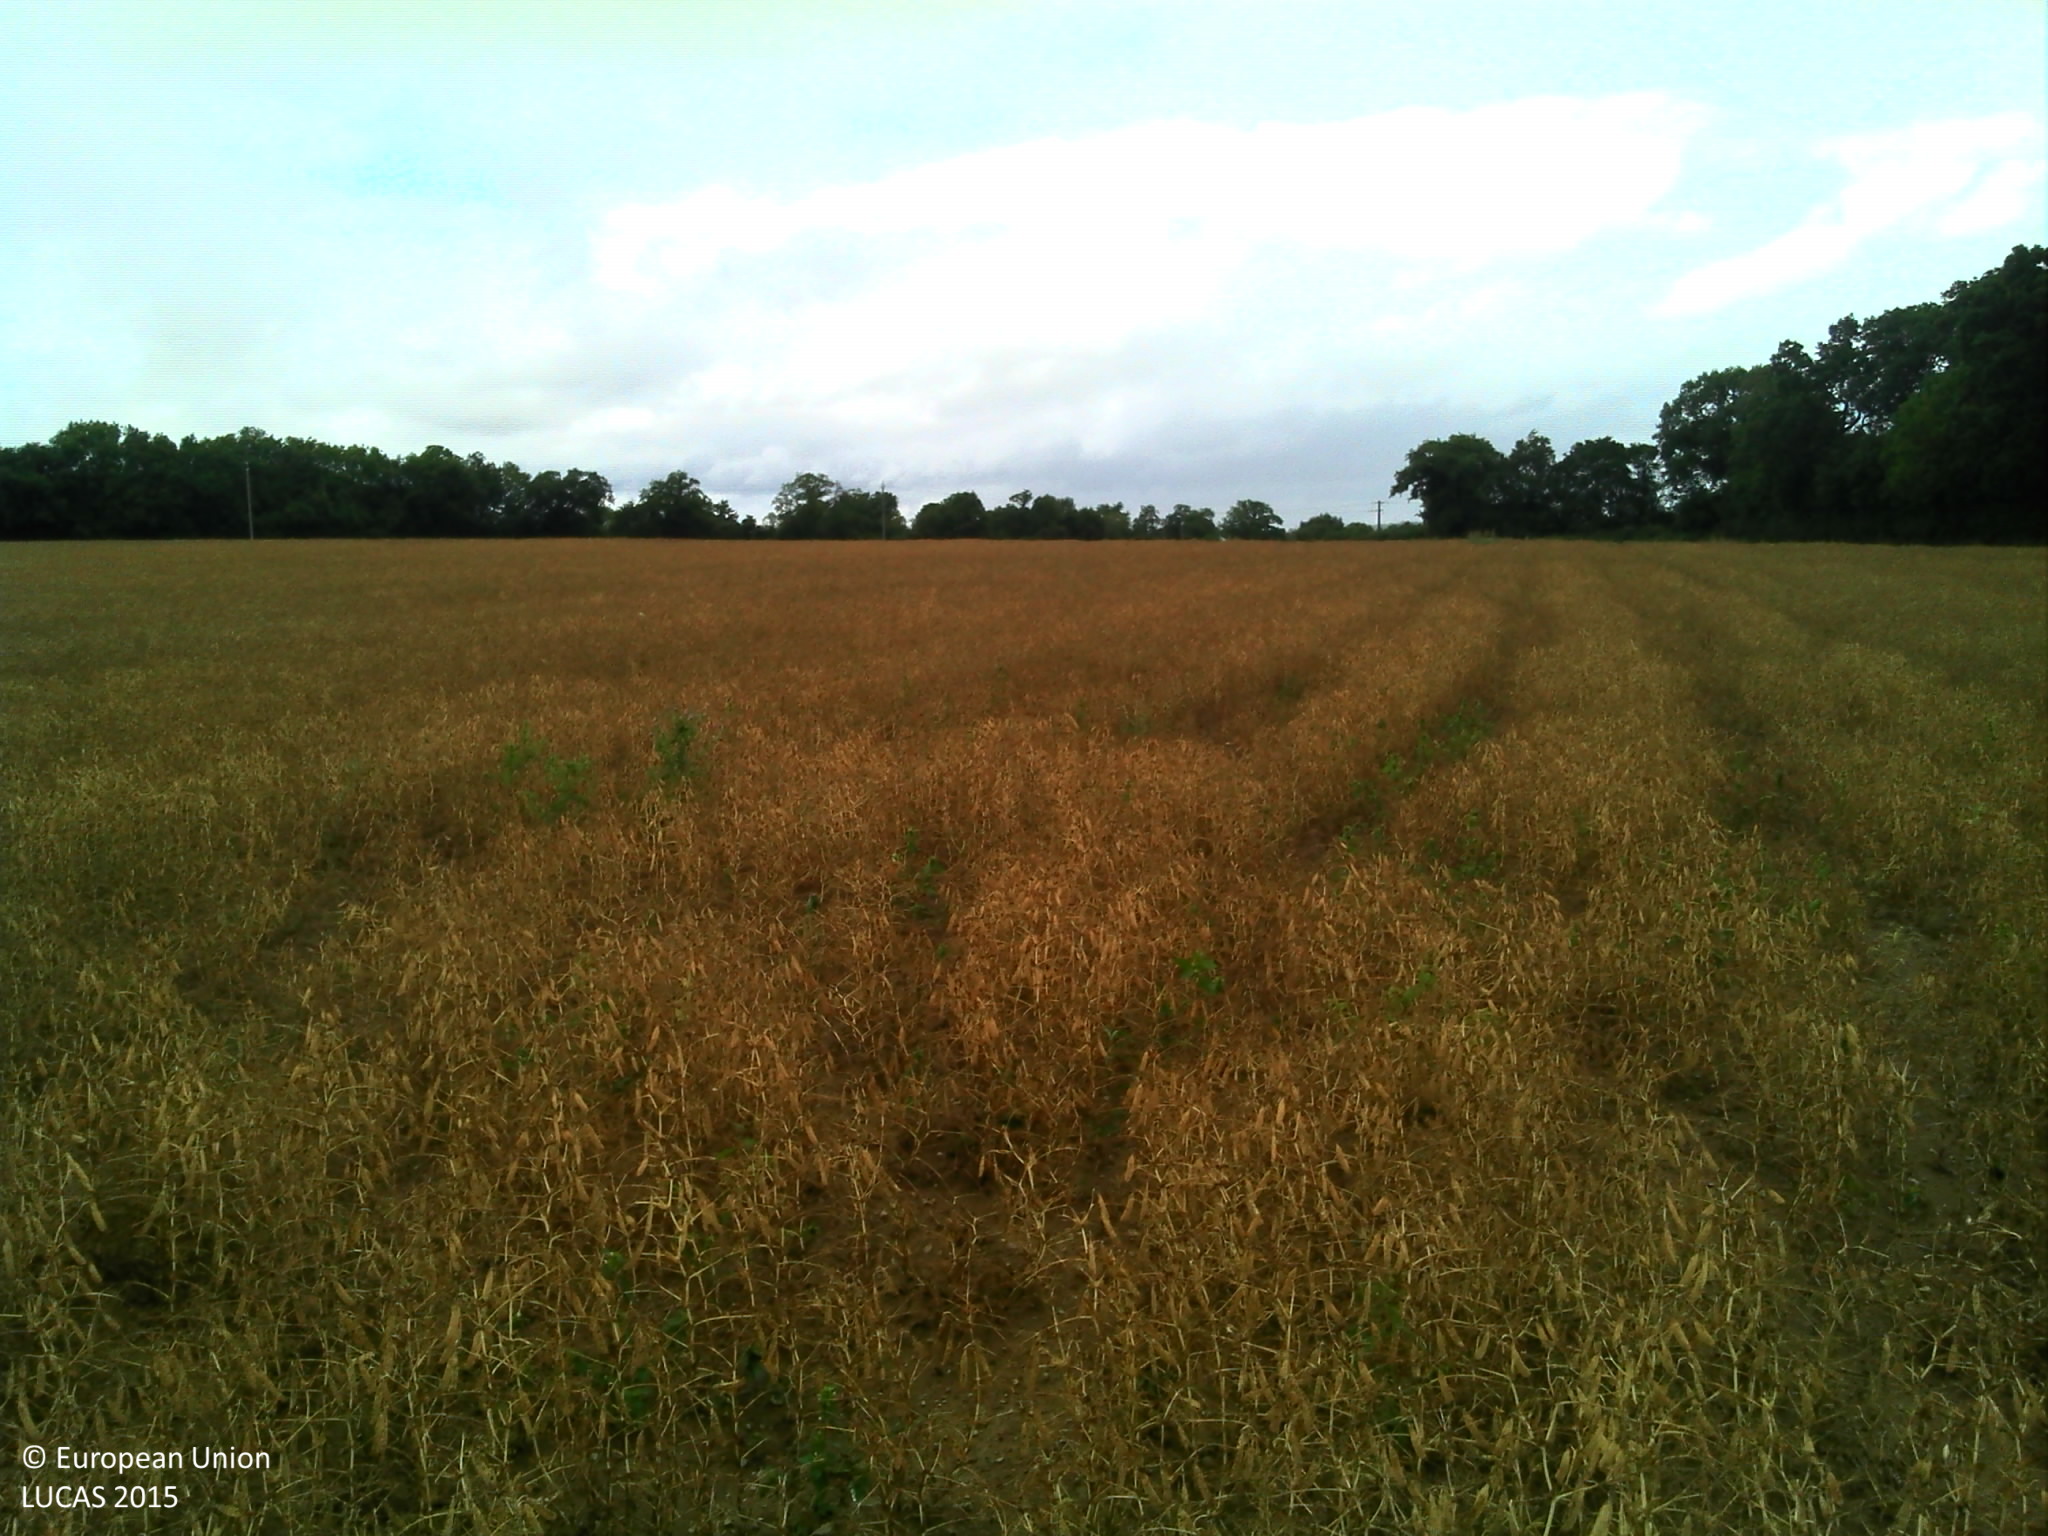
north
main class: Cropland
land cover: Dry pulses
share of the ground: > 75 %
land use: Agriculture (excluding fallow land and kitchen gardens)
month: July
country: FR
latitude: 48.8314
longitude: -0.2638
